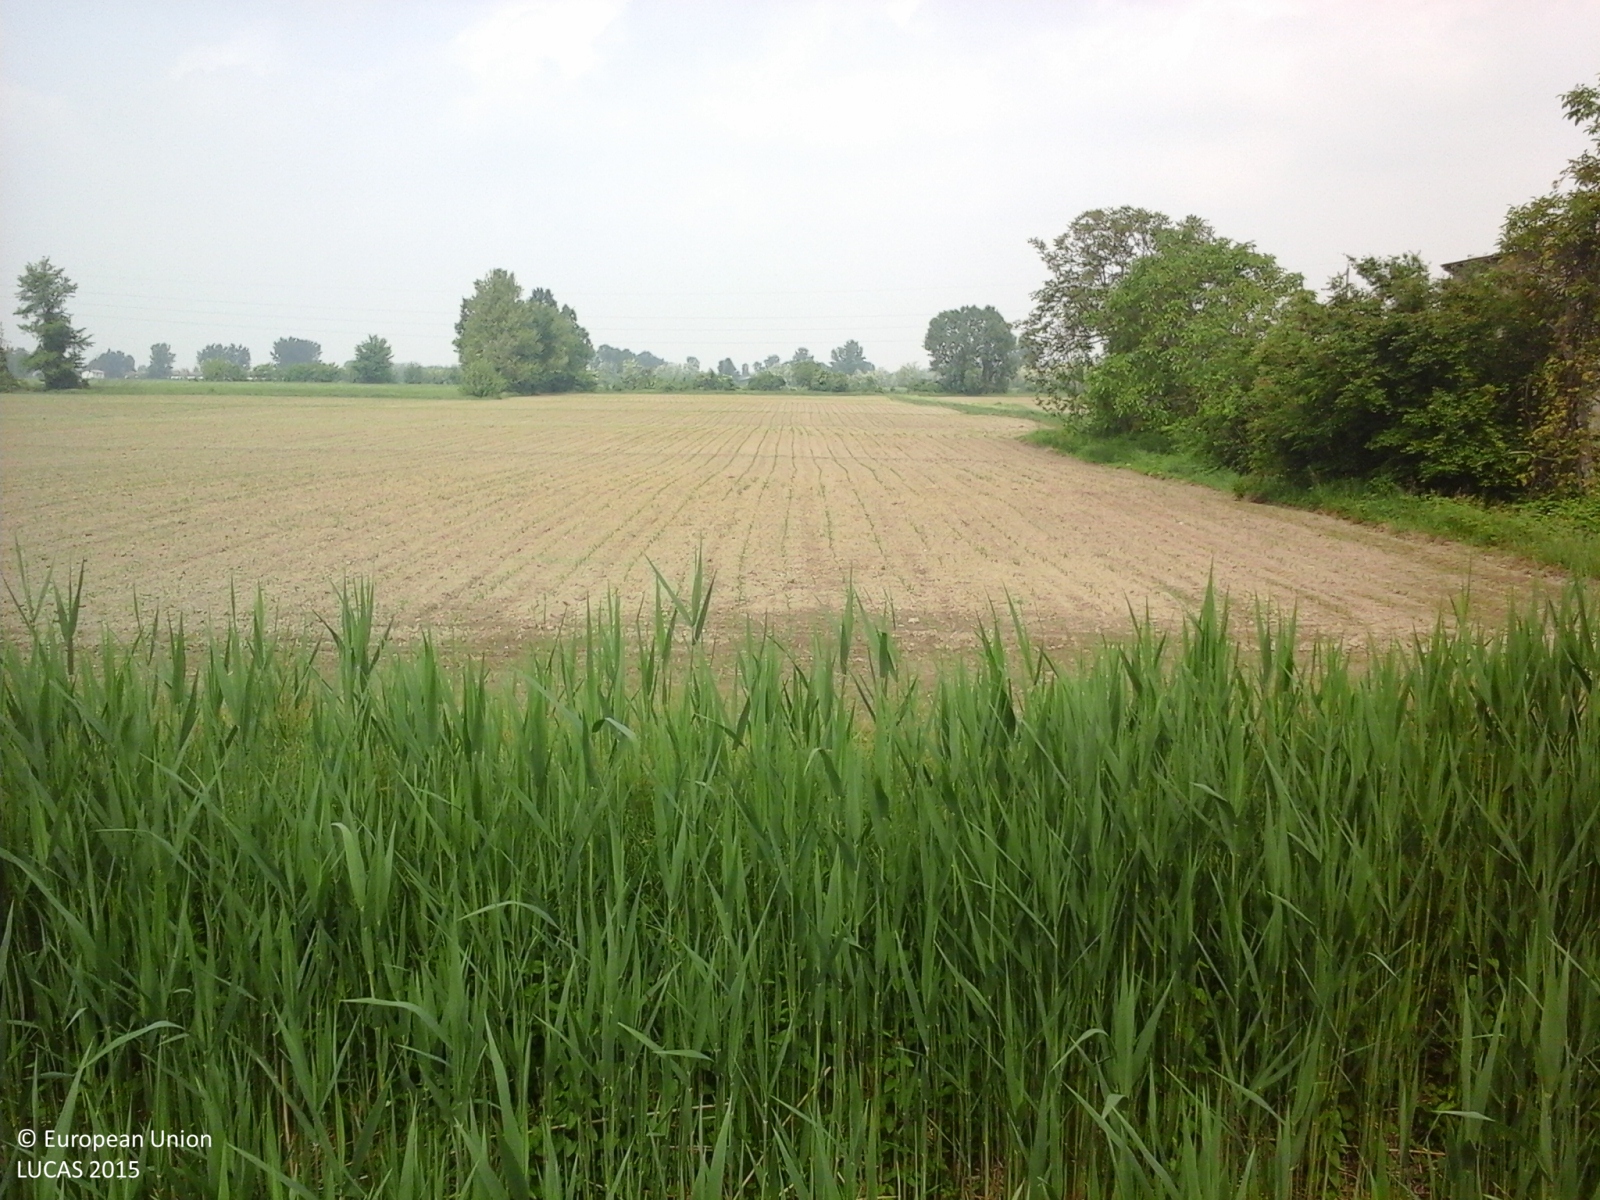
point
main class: Cropland
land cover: Maize
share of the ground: < 10 %
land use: Agriculture (excluding fallow land and kitchen gardens)
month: May
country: IT
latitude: 45.1796
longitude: 10.2667
